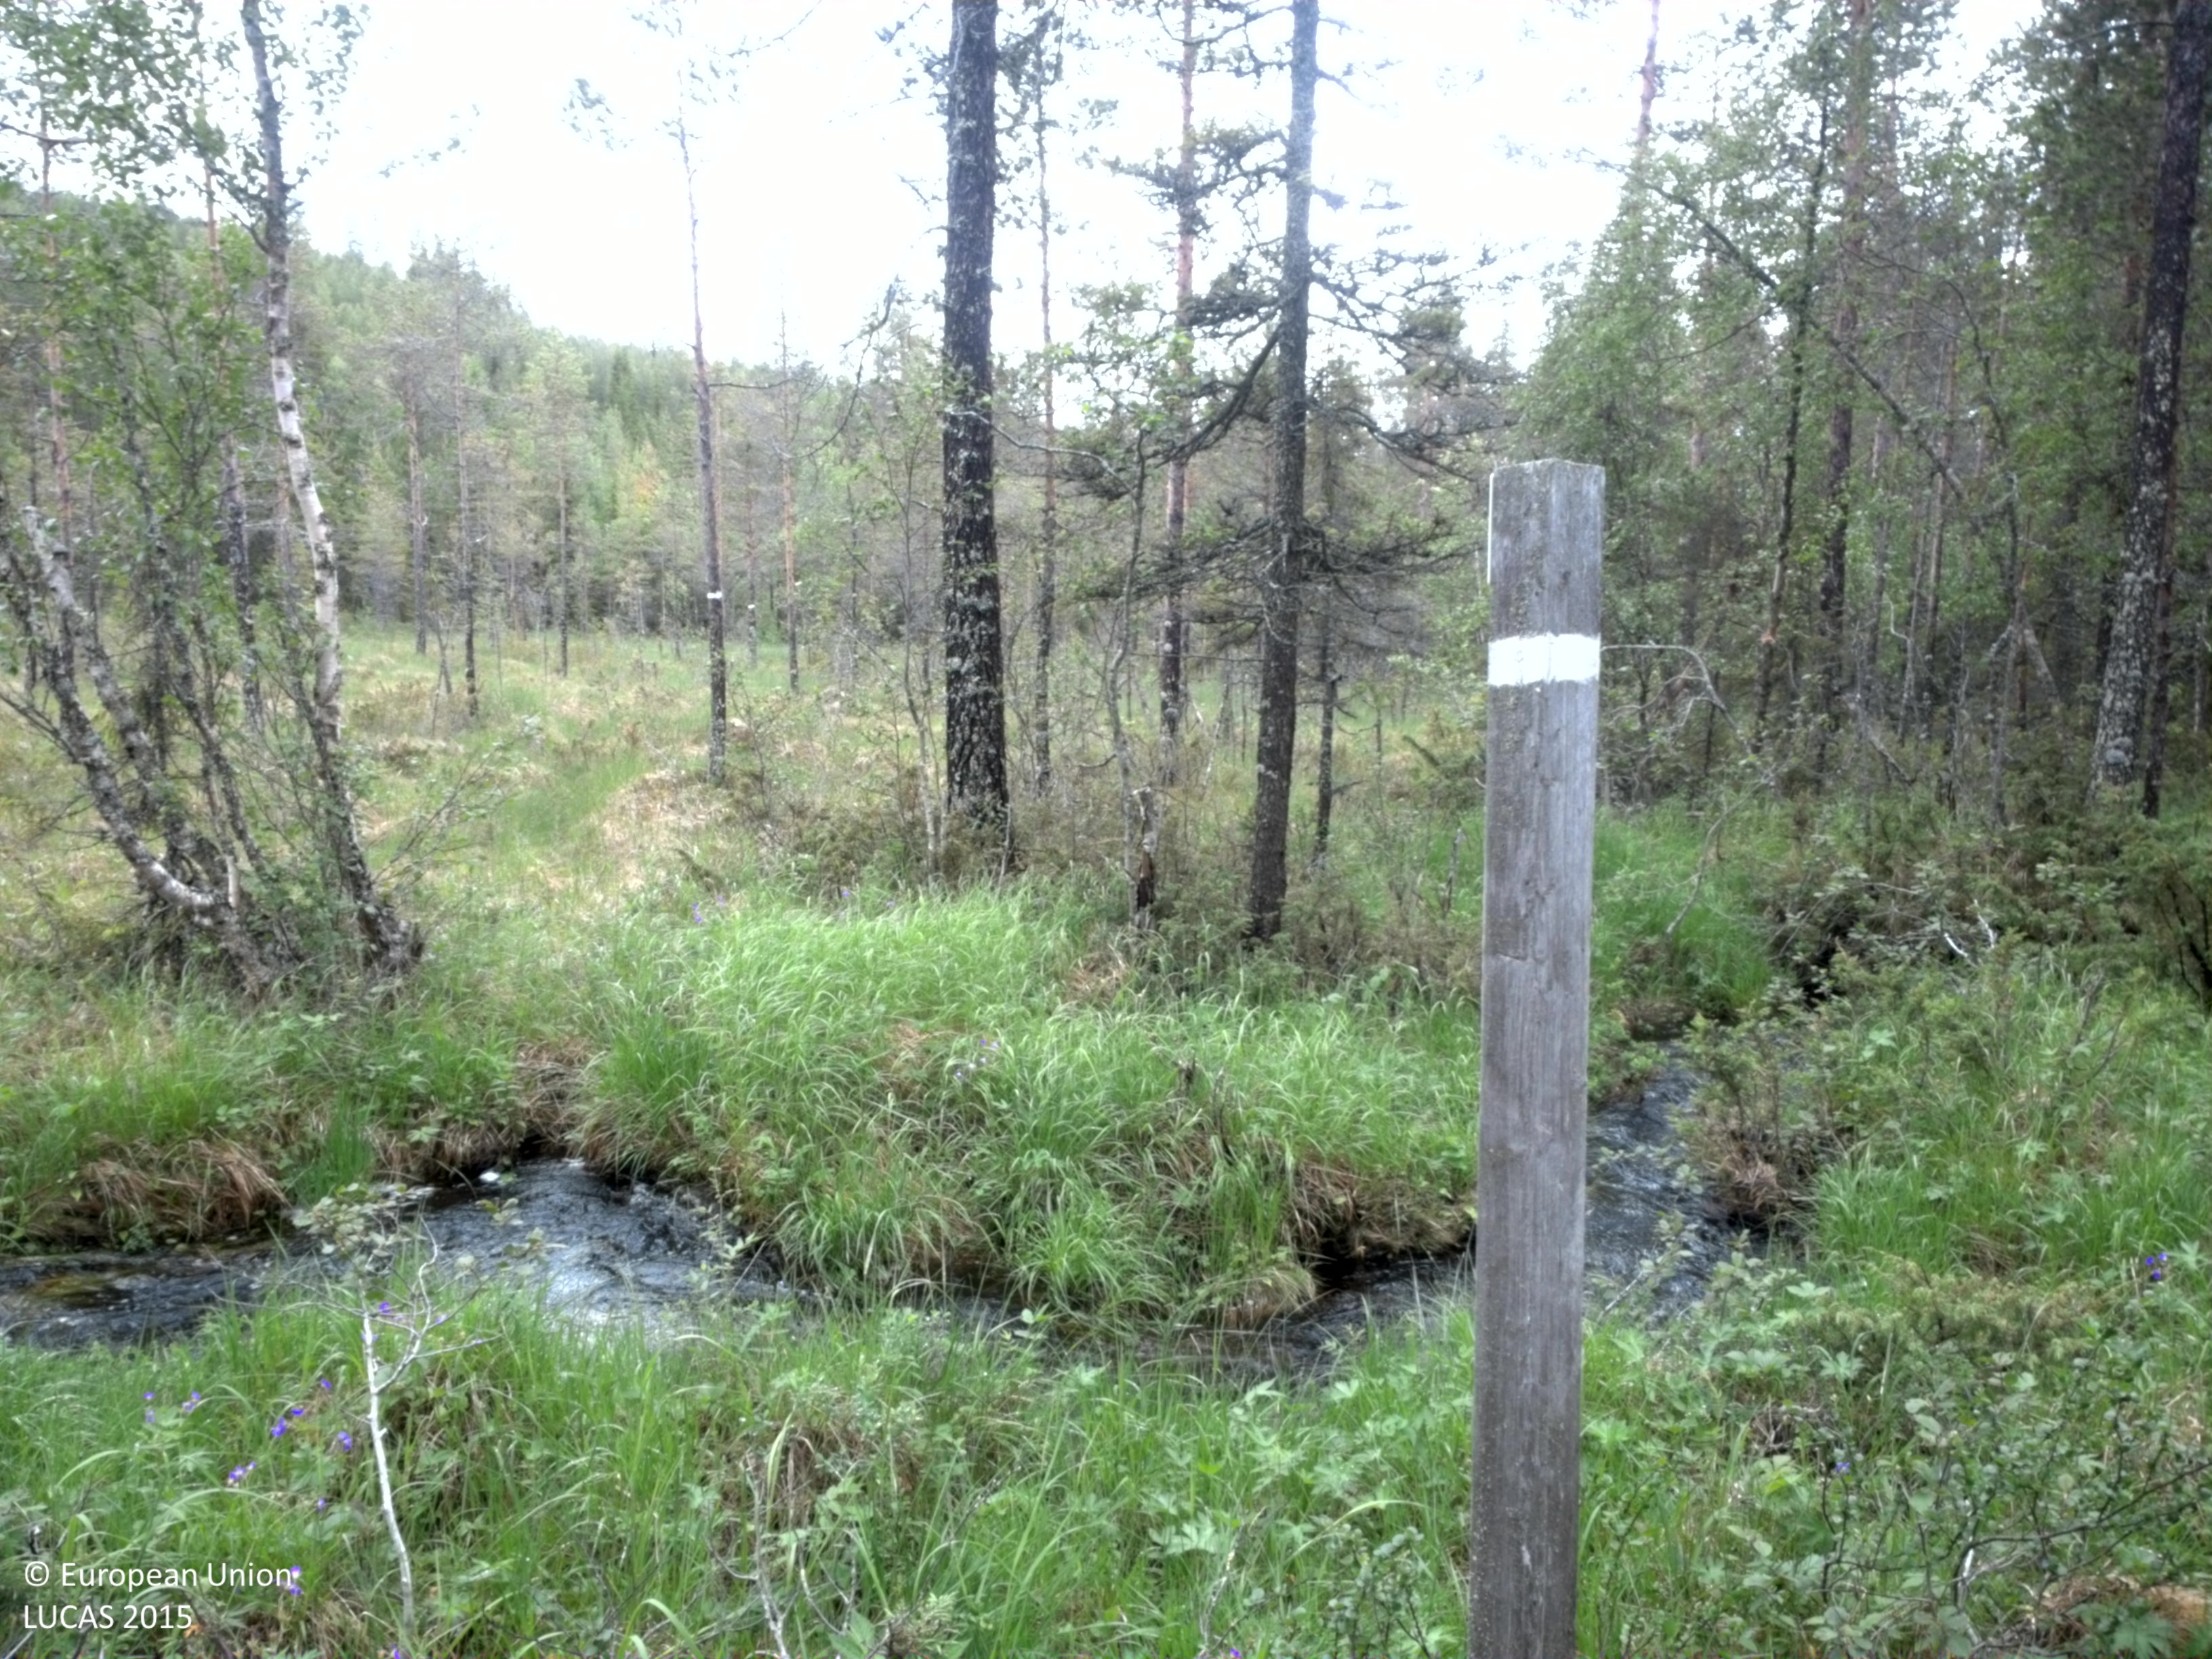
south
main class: Woodland
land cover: Pine dominated mixed woodland
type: boreal forest
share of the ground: 50 - 75 %
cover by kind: coniferous forest trees 45 %, shrubs 20 %, herbaceous plants 20 %, broadleaved forest trees 15 %
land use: Amenities, museums, leisure
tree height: > 5 m
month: July
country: SE
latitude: 64.6523
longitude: 18.3199
